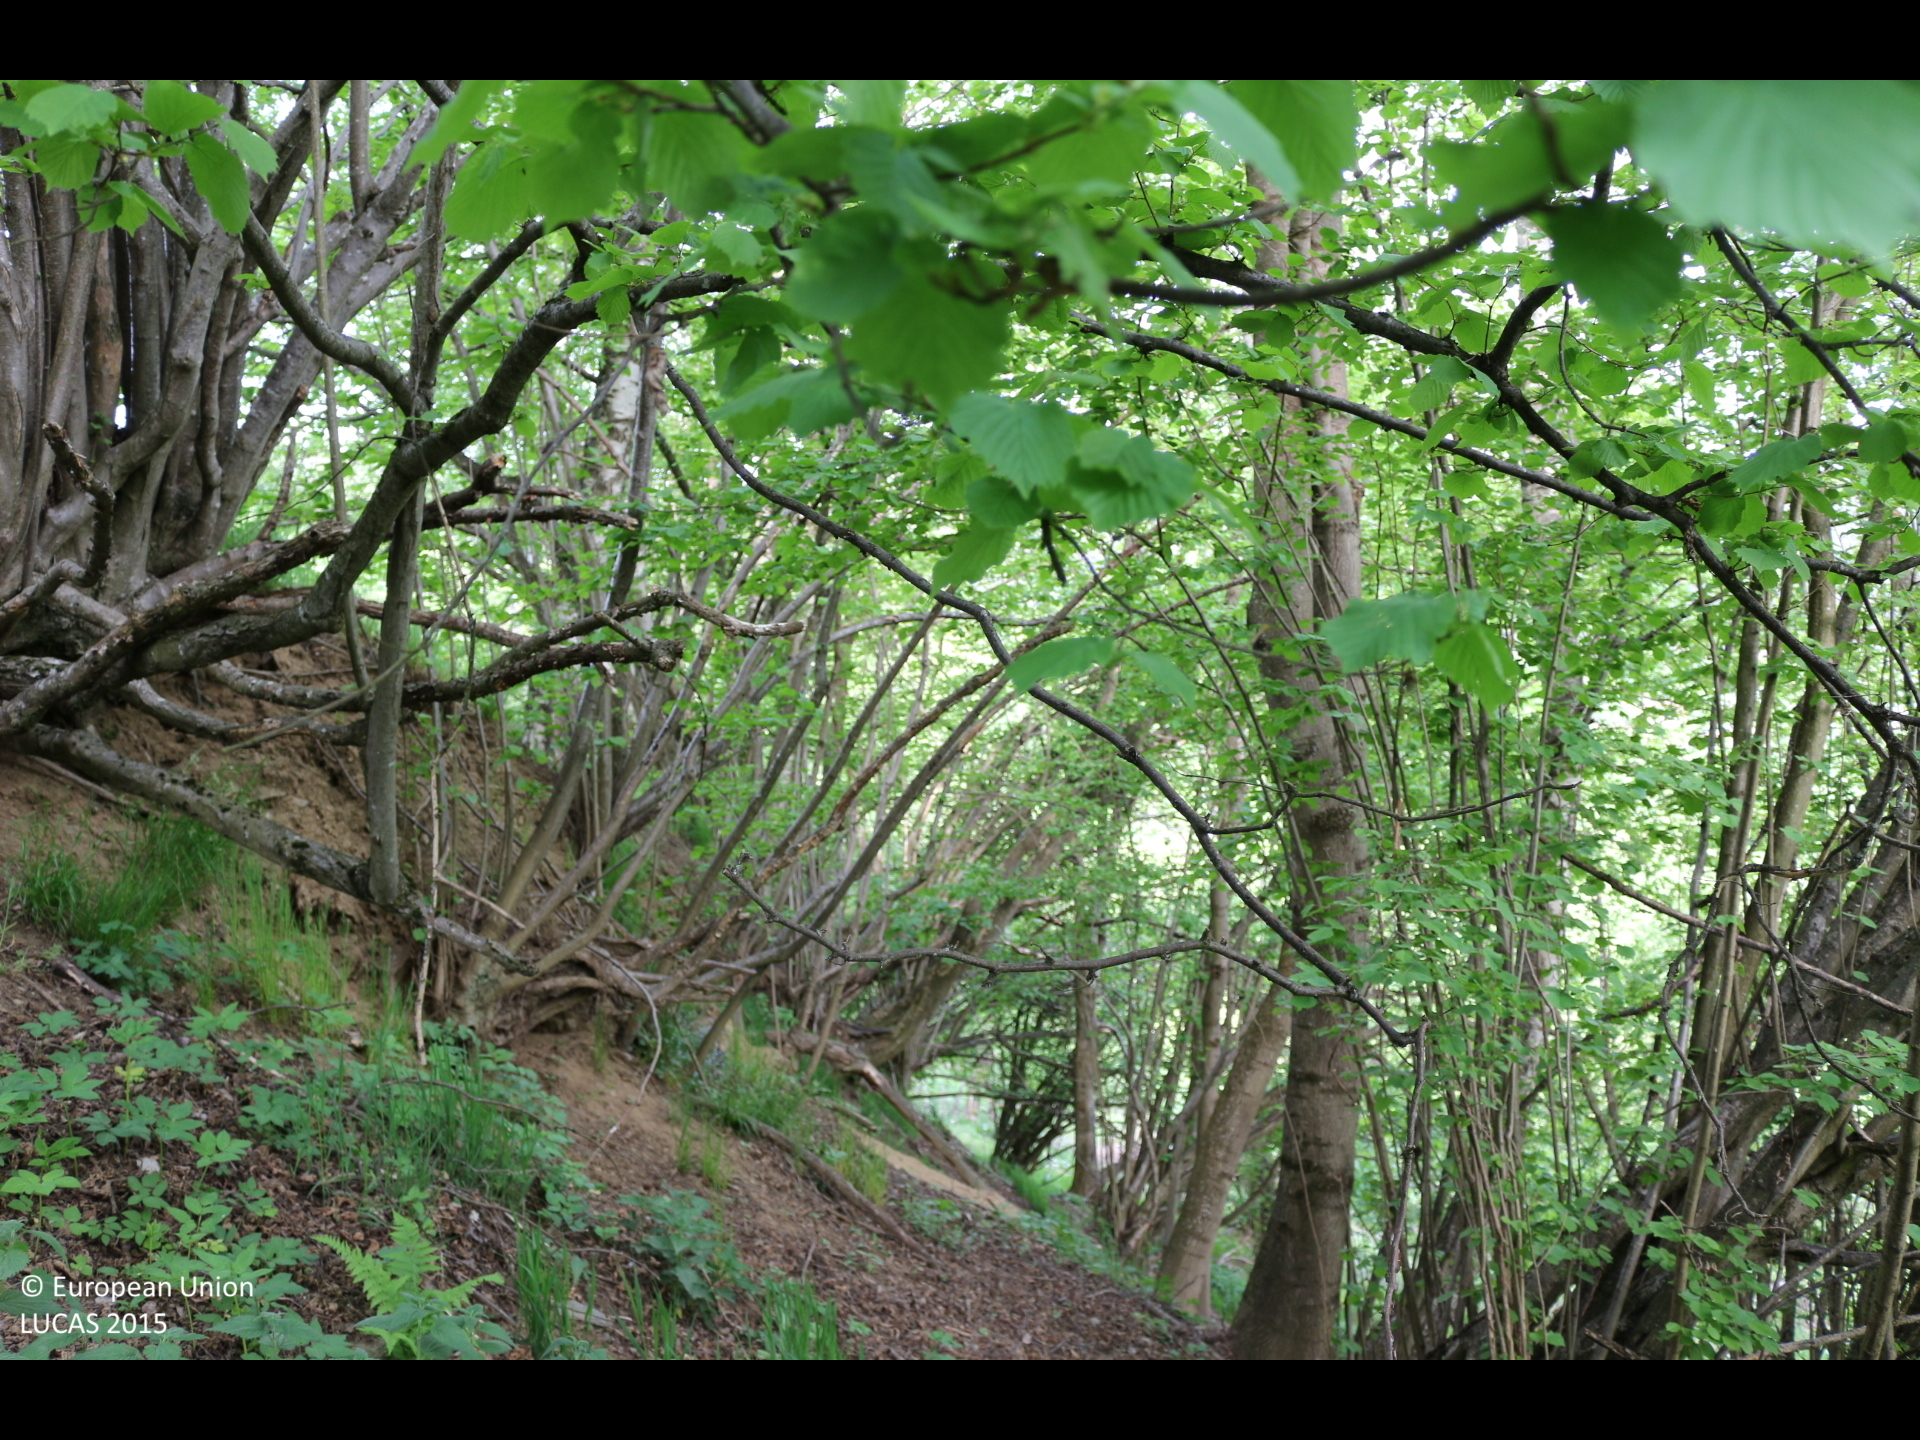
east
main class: Woodland
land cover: Broadleaved woodland
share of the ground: > 75 %
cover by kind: broadleaved forest trees 90 %, shrubs 5 %, herbaceous plants 5 %
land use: Forestry
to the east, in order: Broadleaved woodland; Grassland without tree/shrub cover; Electric lines; Grassland without tree/shrub cover; Electric lines; Grassland without tree/shrub cover; Fences; Grassland without tree/shrub cover; Tracks; Broadleaved woodland; Fences; Grassland without tree/shrub cover
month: May
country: AT
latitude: 46.7757
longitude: 14.1492
